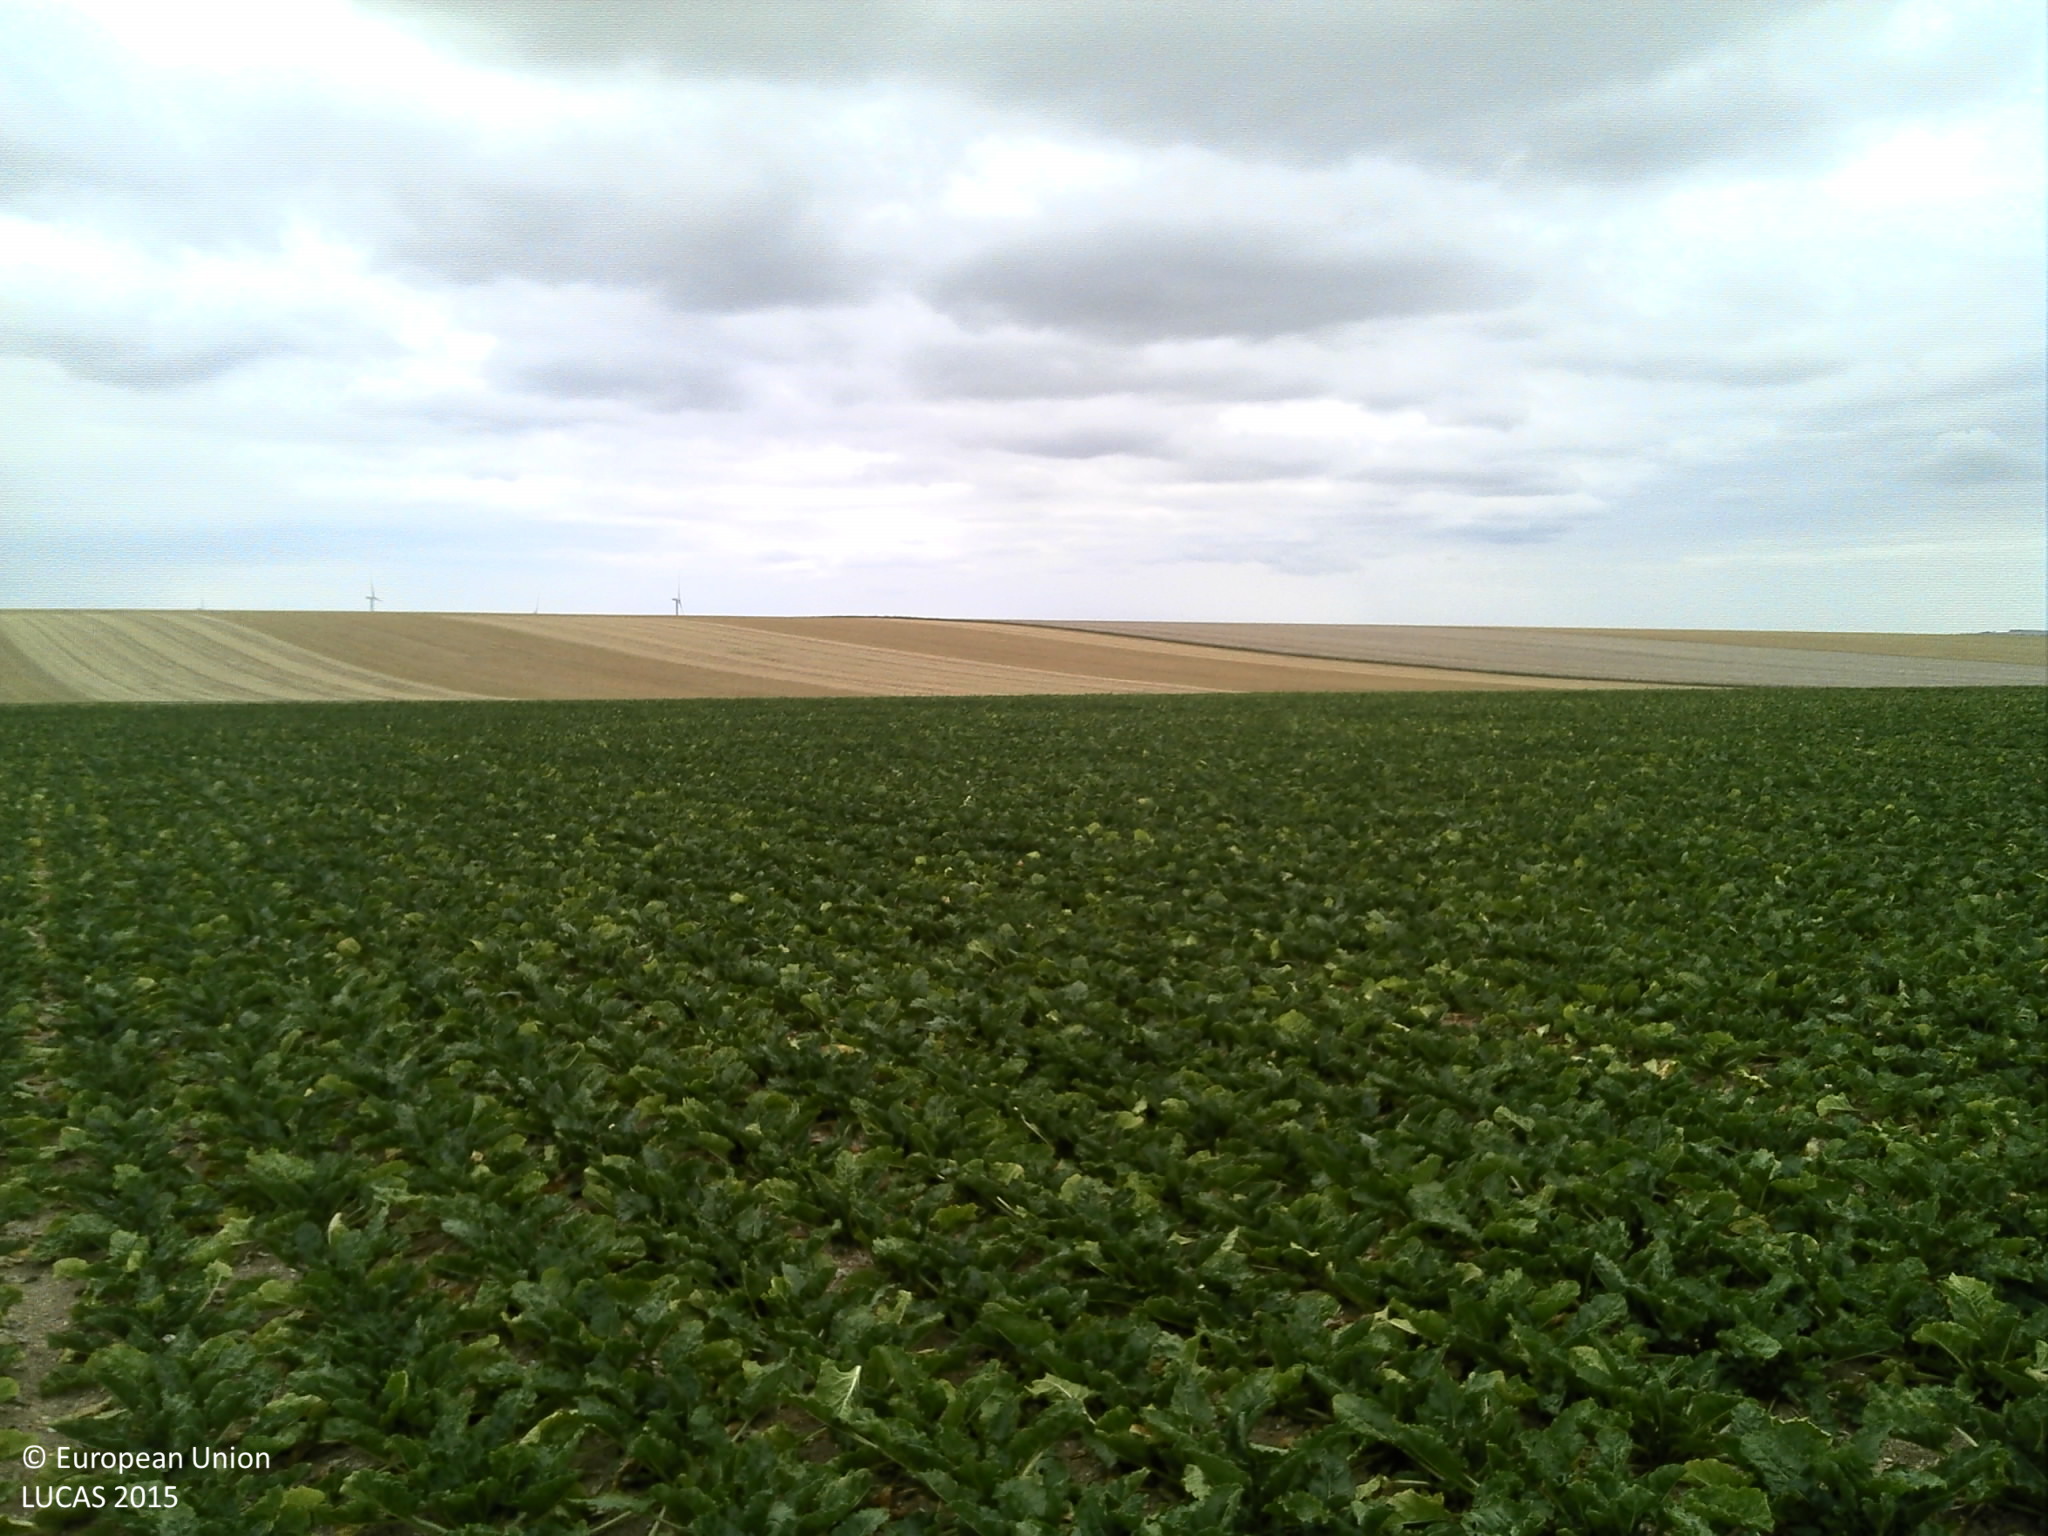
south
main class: Cropland
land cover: Sugar beet
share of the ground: > 75 %
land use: Agriculture (excluding fallow land and kitchen gardens)
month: August
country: FR
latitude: 48.4660
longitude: 4.1672
